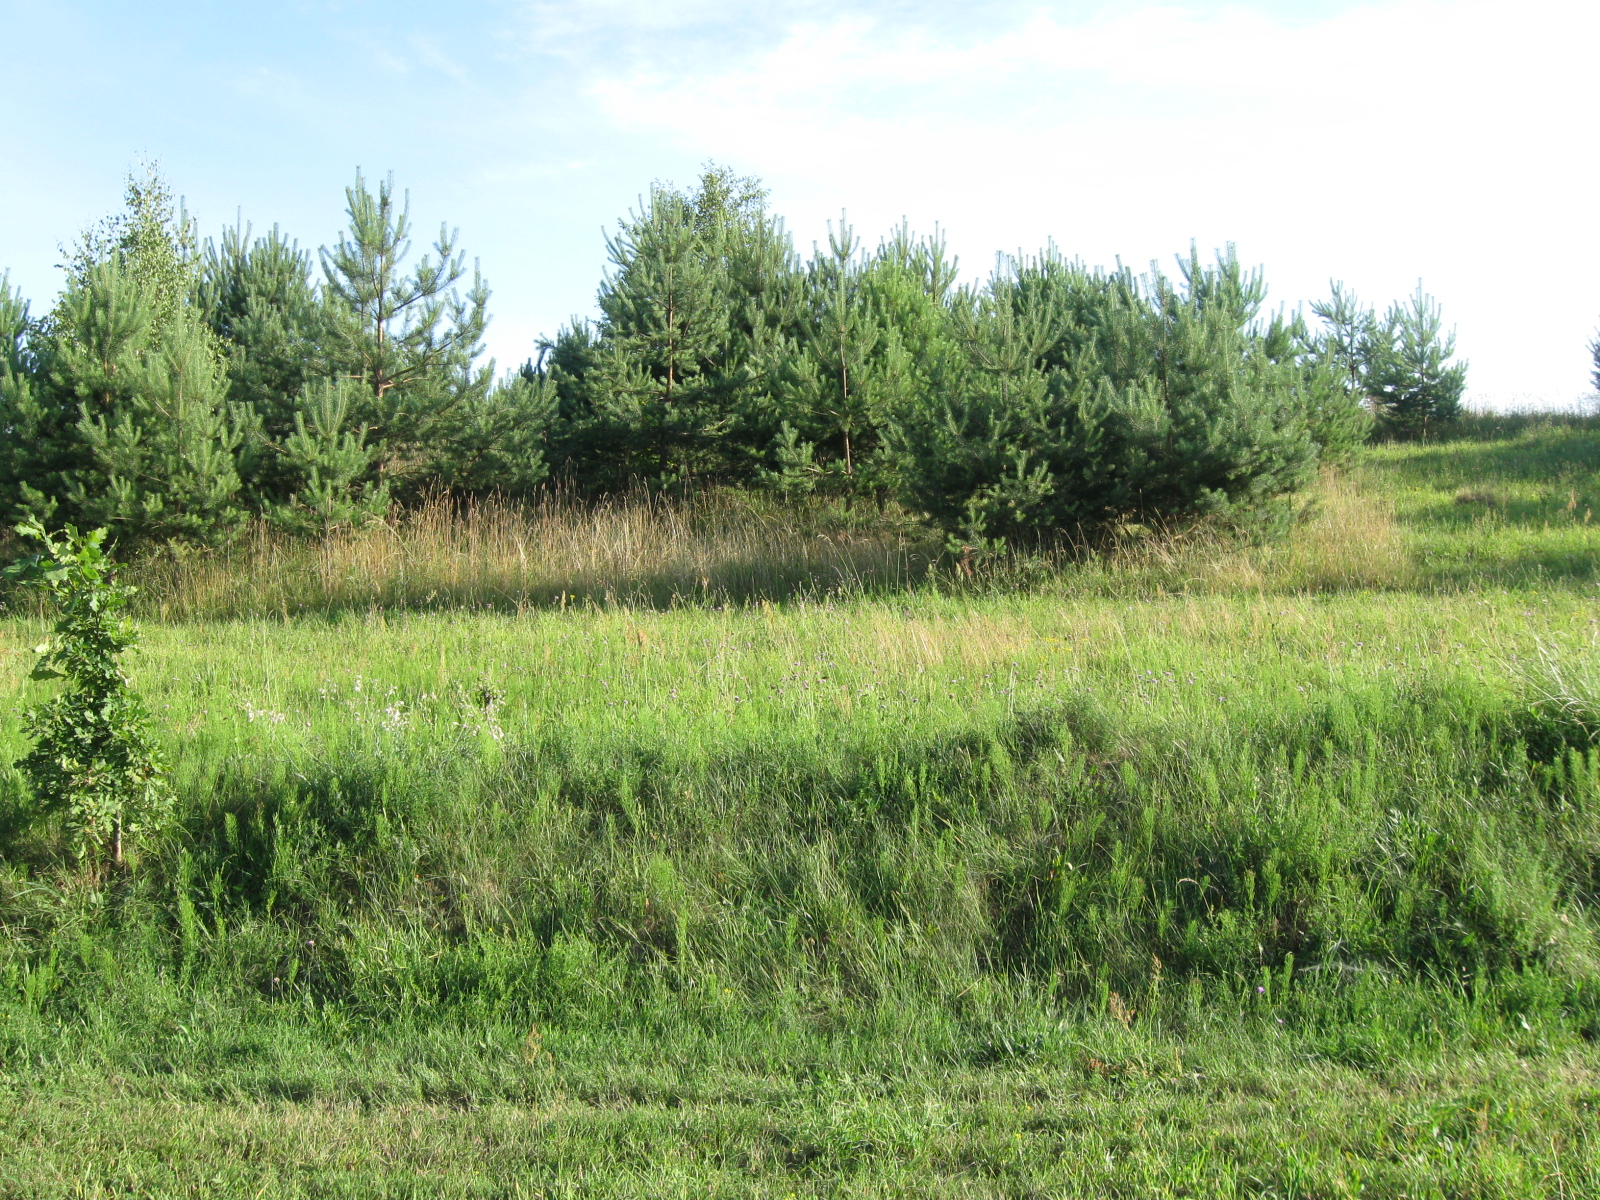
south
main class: Grassland
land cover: Spontaneously vegetated surfaces
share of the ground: > 75 %
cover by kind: herbaceous plants 100 %
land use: Agriculture (excluding fallow land and kitchen gardens)
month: July
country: LT
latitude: 54.4549
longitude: 24.3993
